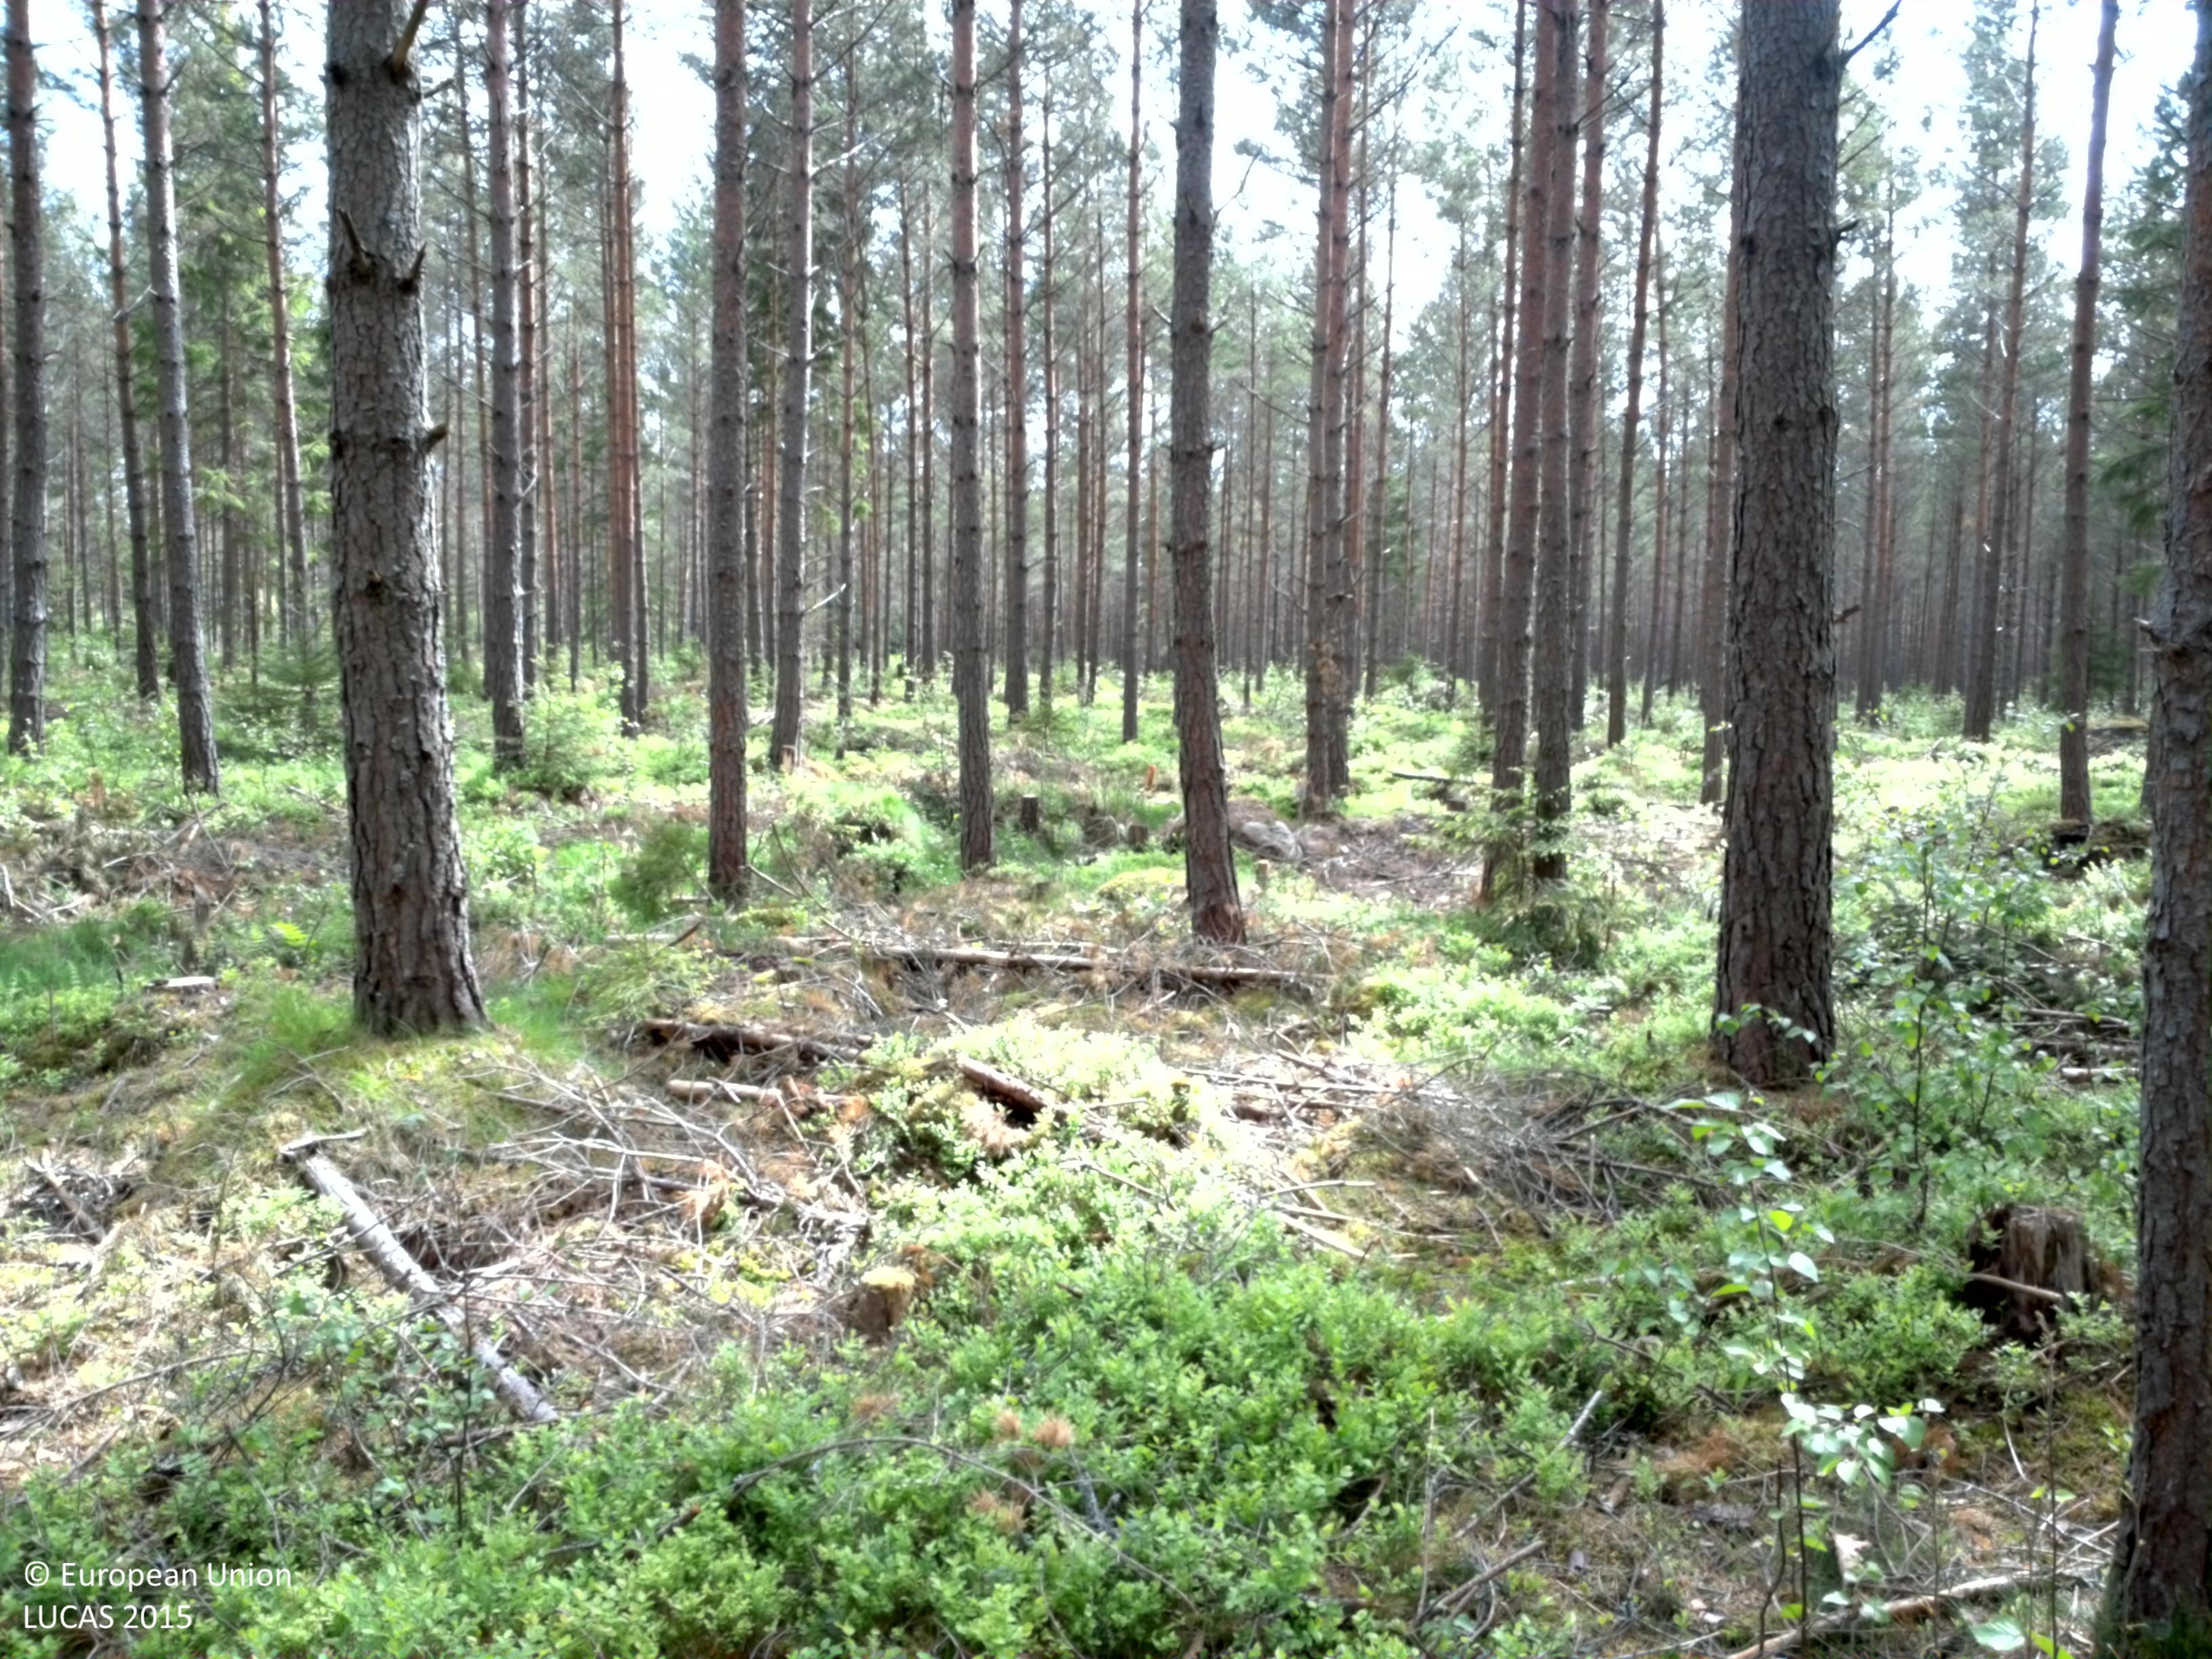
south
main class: Woodland
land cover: Pine dominated coniferous woodland
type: boreal forest
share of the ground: 50 - 75 %
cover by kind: coniferous forest trees 65 %, shrubs 25 %, broadleaved forest trees 10 %
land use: Forestry
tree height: > 5 m
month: June
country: SE
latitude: 58.2871
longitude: 13.9681
